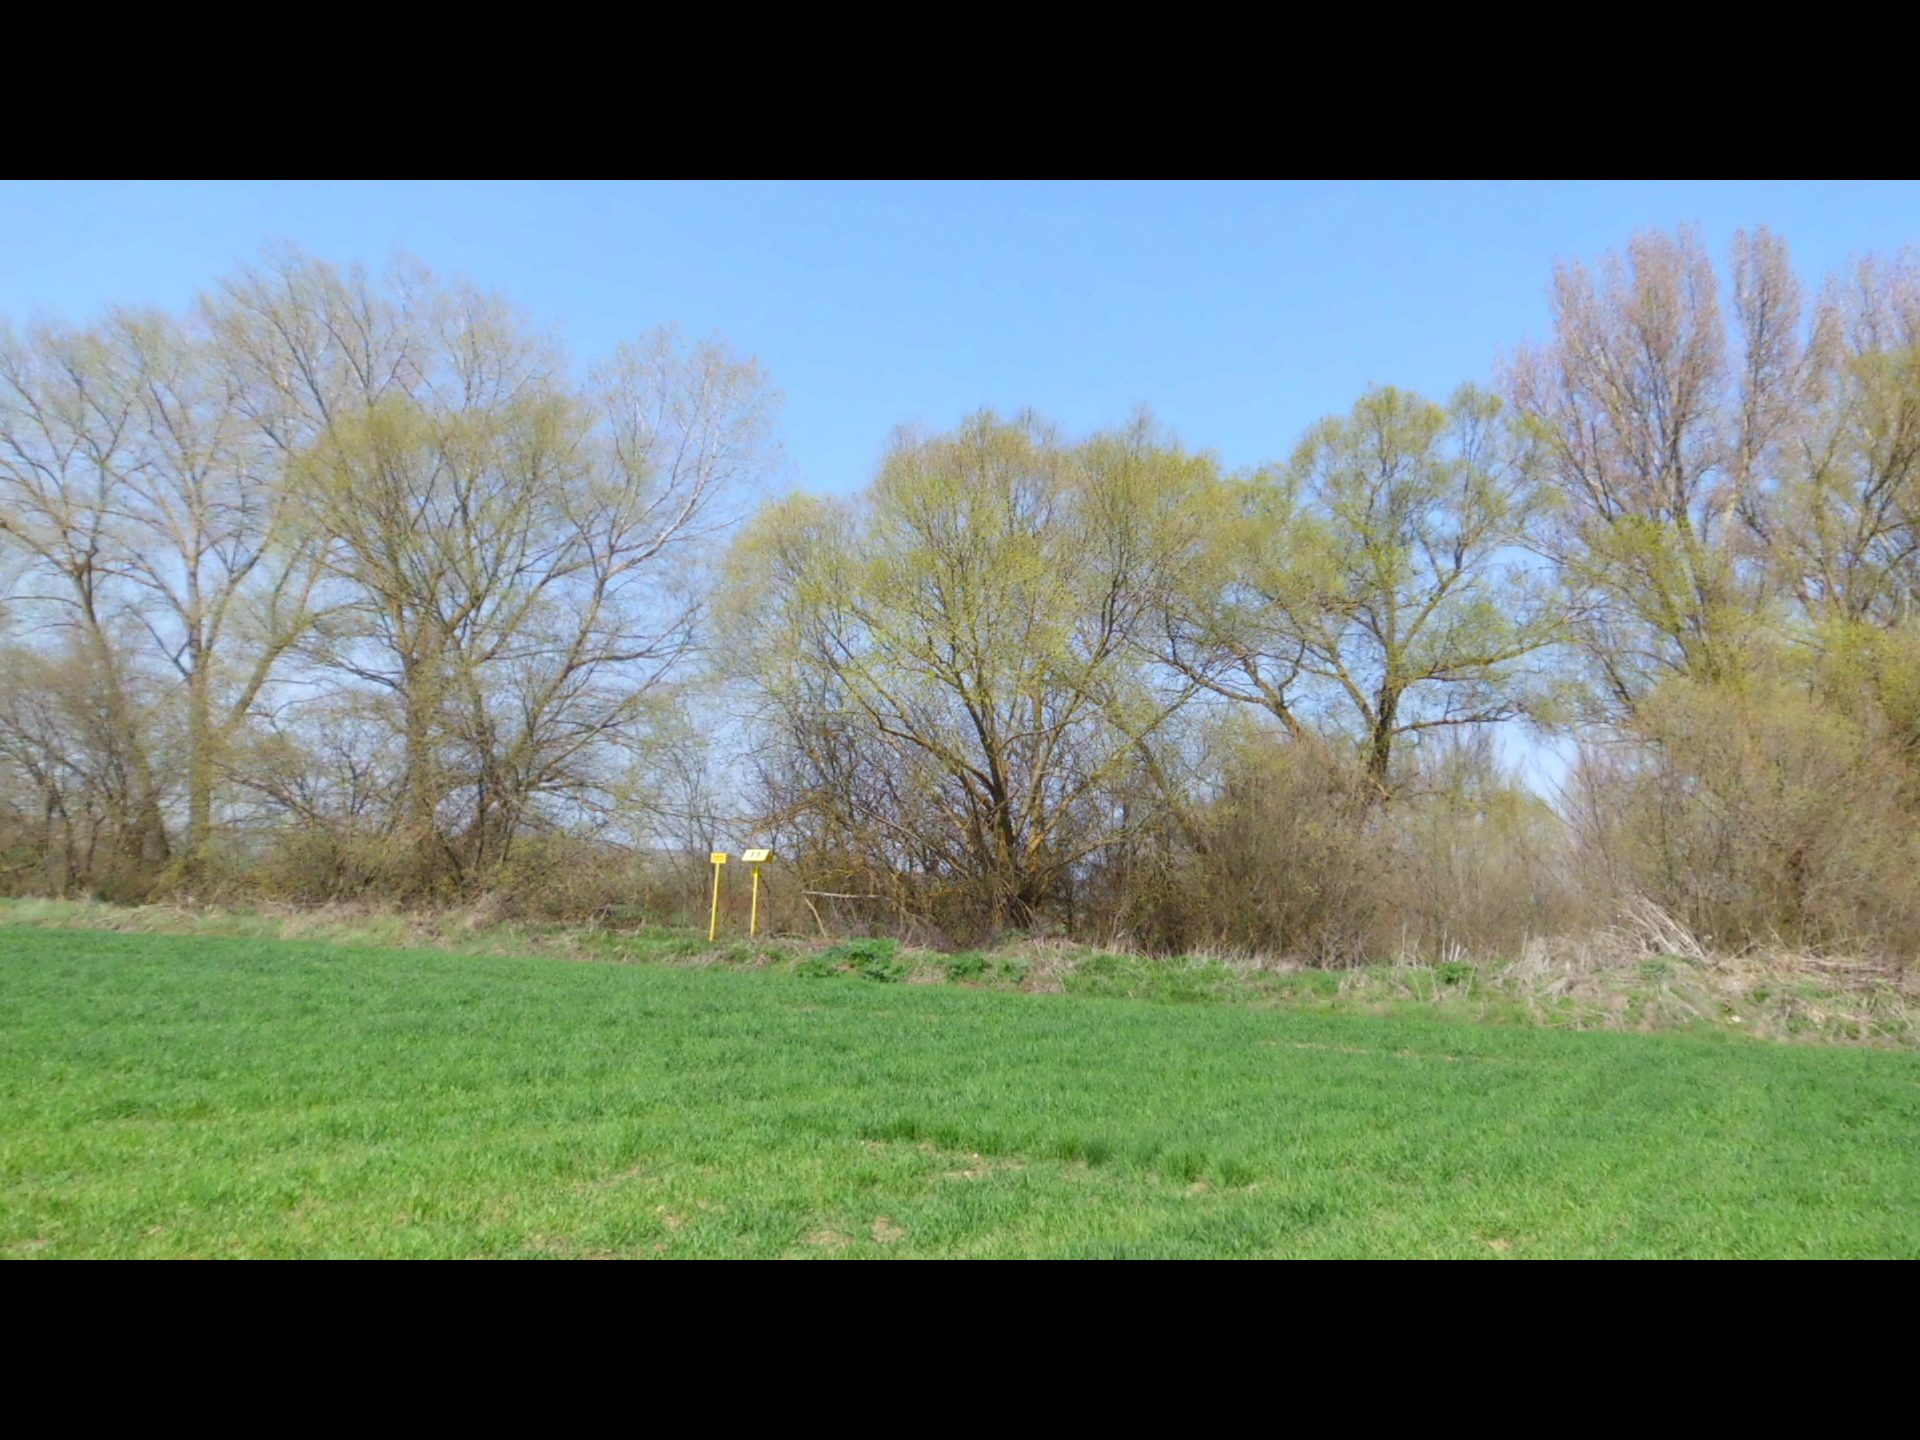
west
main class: Cropland
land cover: Common wheat
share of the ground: > 75 %
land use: Agriculture (excluding fallow land and kitchen gardens)
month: April
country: ES
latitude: 42.4686
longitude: -3.6959
